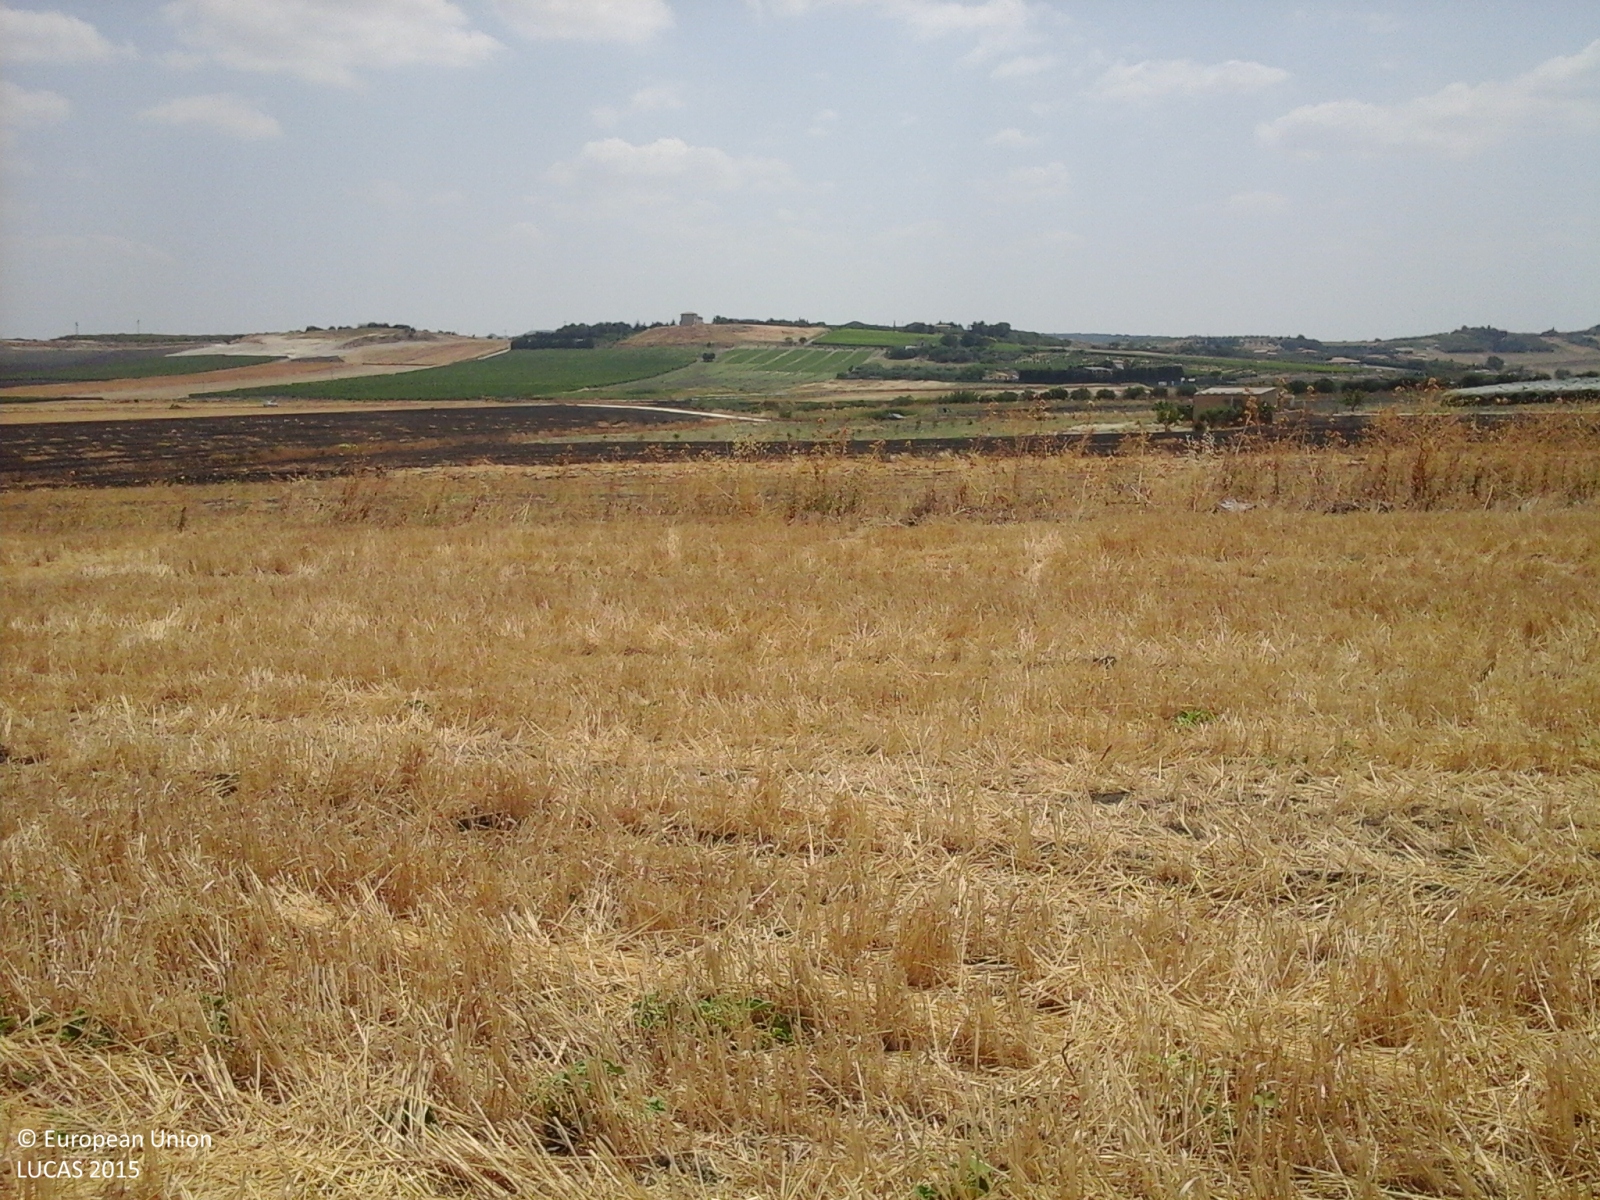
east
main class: Cropland
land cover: Durum wheat
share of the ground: > 75 %
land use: Agriculture (excluding fallow land and kitchen gardens)
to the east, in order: Durum wheat; Spontaneously vegetated surfaces; Other root crops; Durum wheat; Olive groves; Spontaneously vegetated surfaces
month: July
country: IT
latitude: 37.2856
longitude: 13.9062
